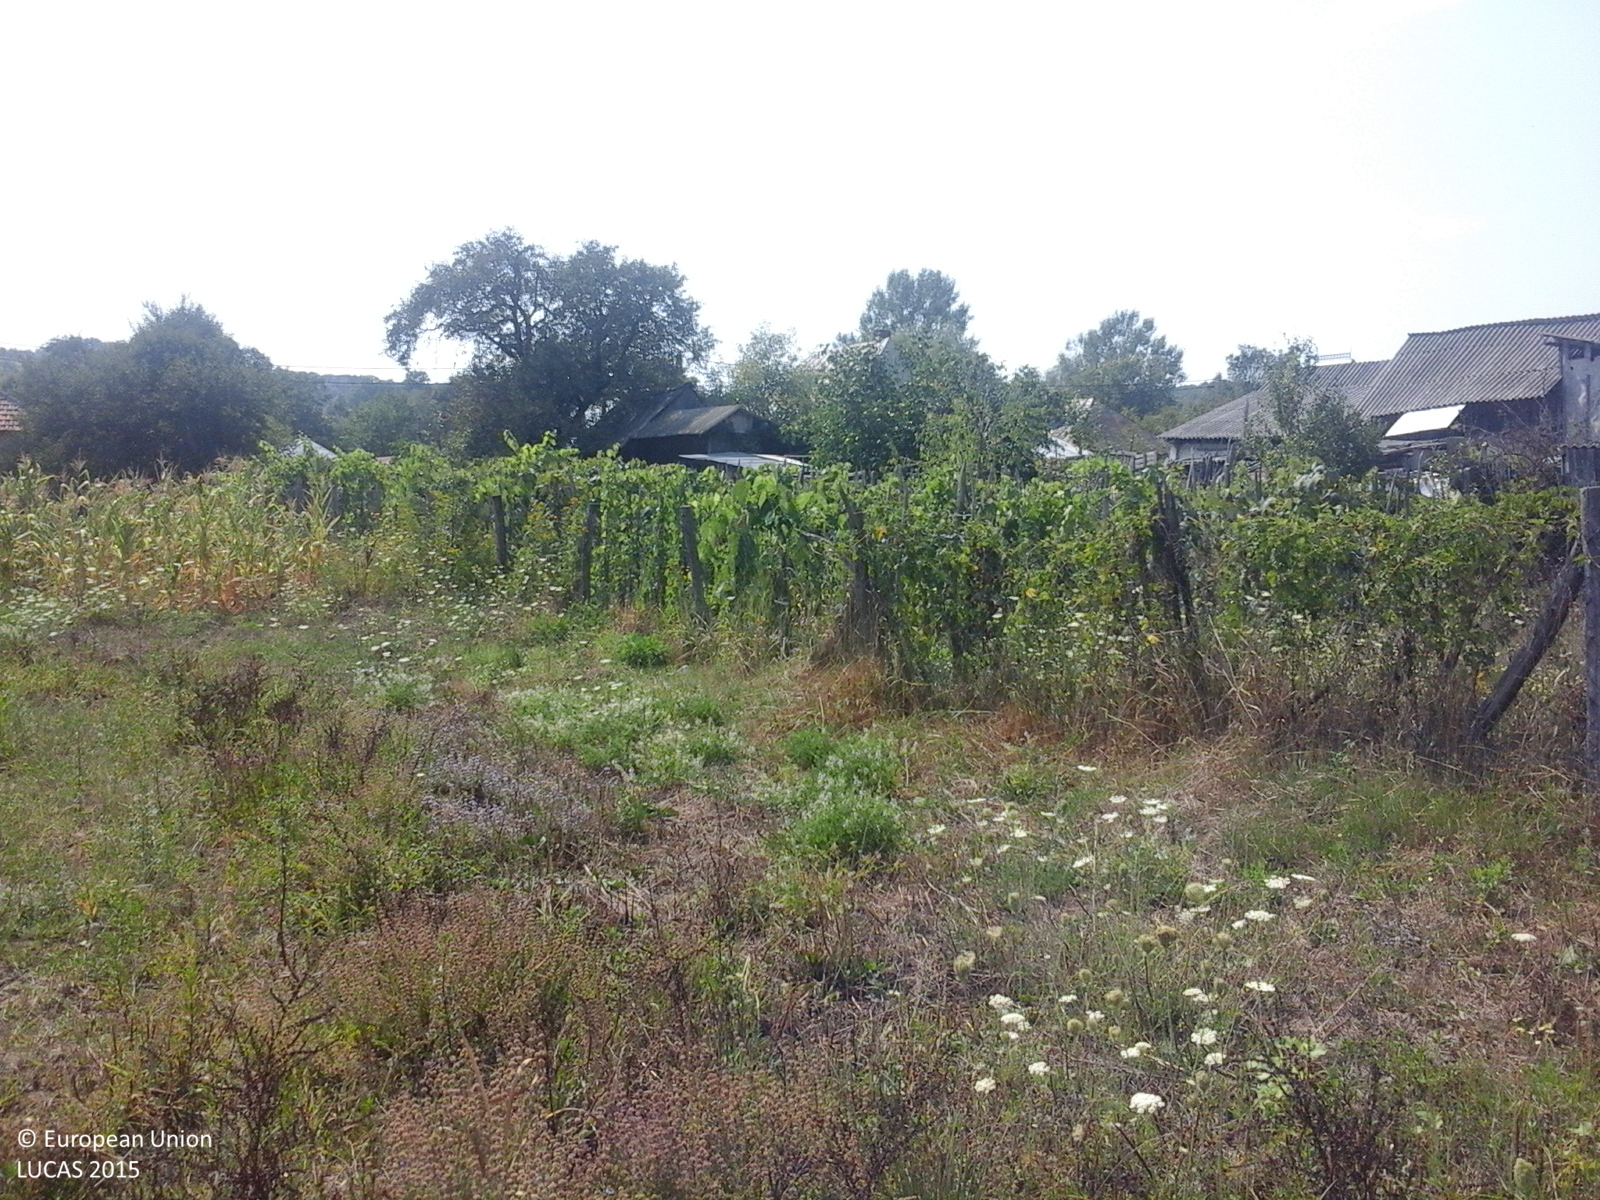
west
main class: Cropland
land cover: Vineyards
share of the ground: 50 - 75 %
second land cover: Other bare soil
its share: > 75 %
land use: Agriculture (excluding fallow land and kitchen gardens)
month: August
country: RO
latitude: 44.6568
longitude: 23.8697
